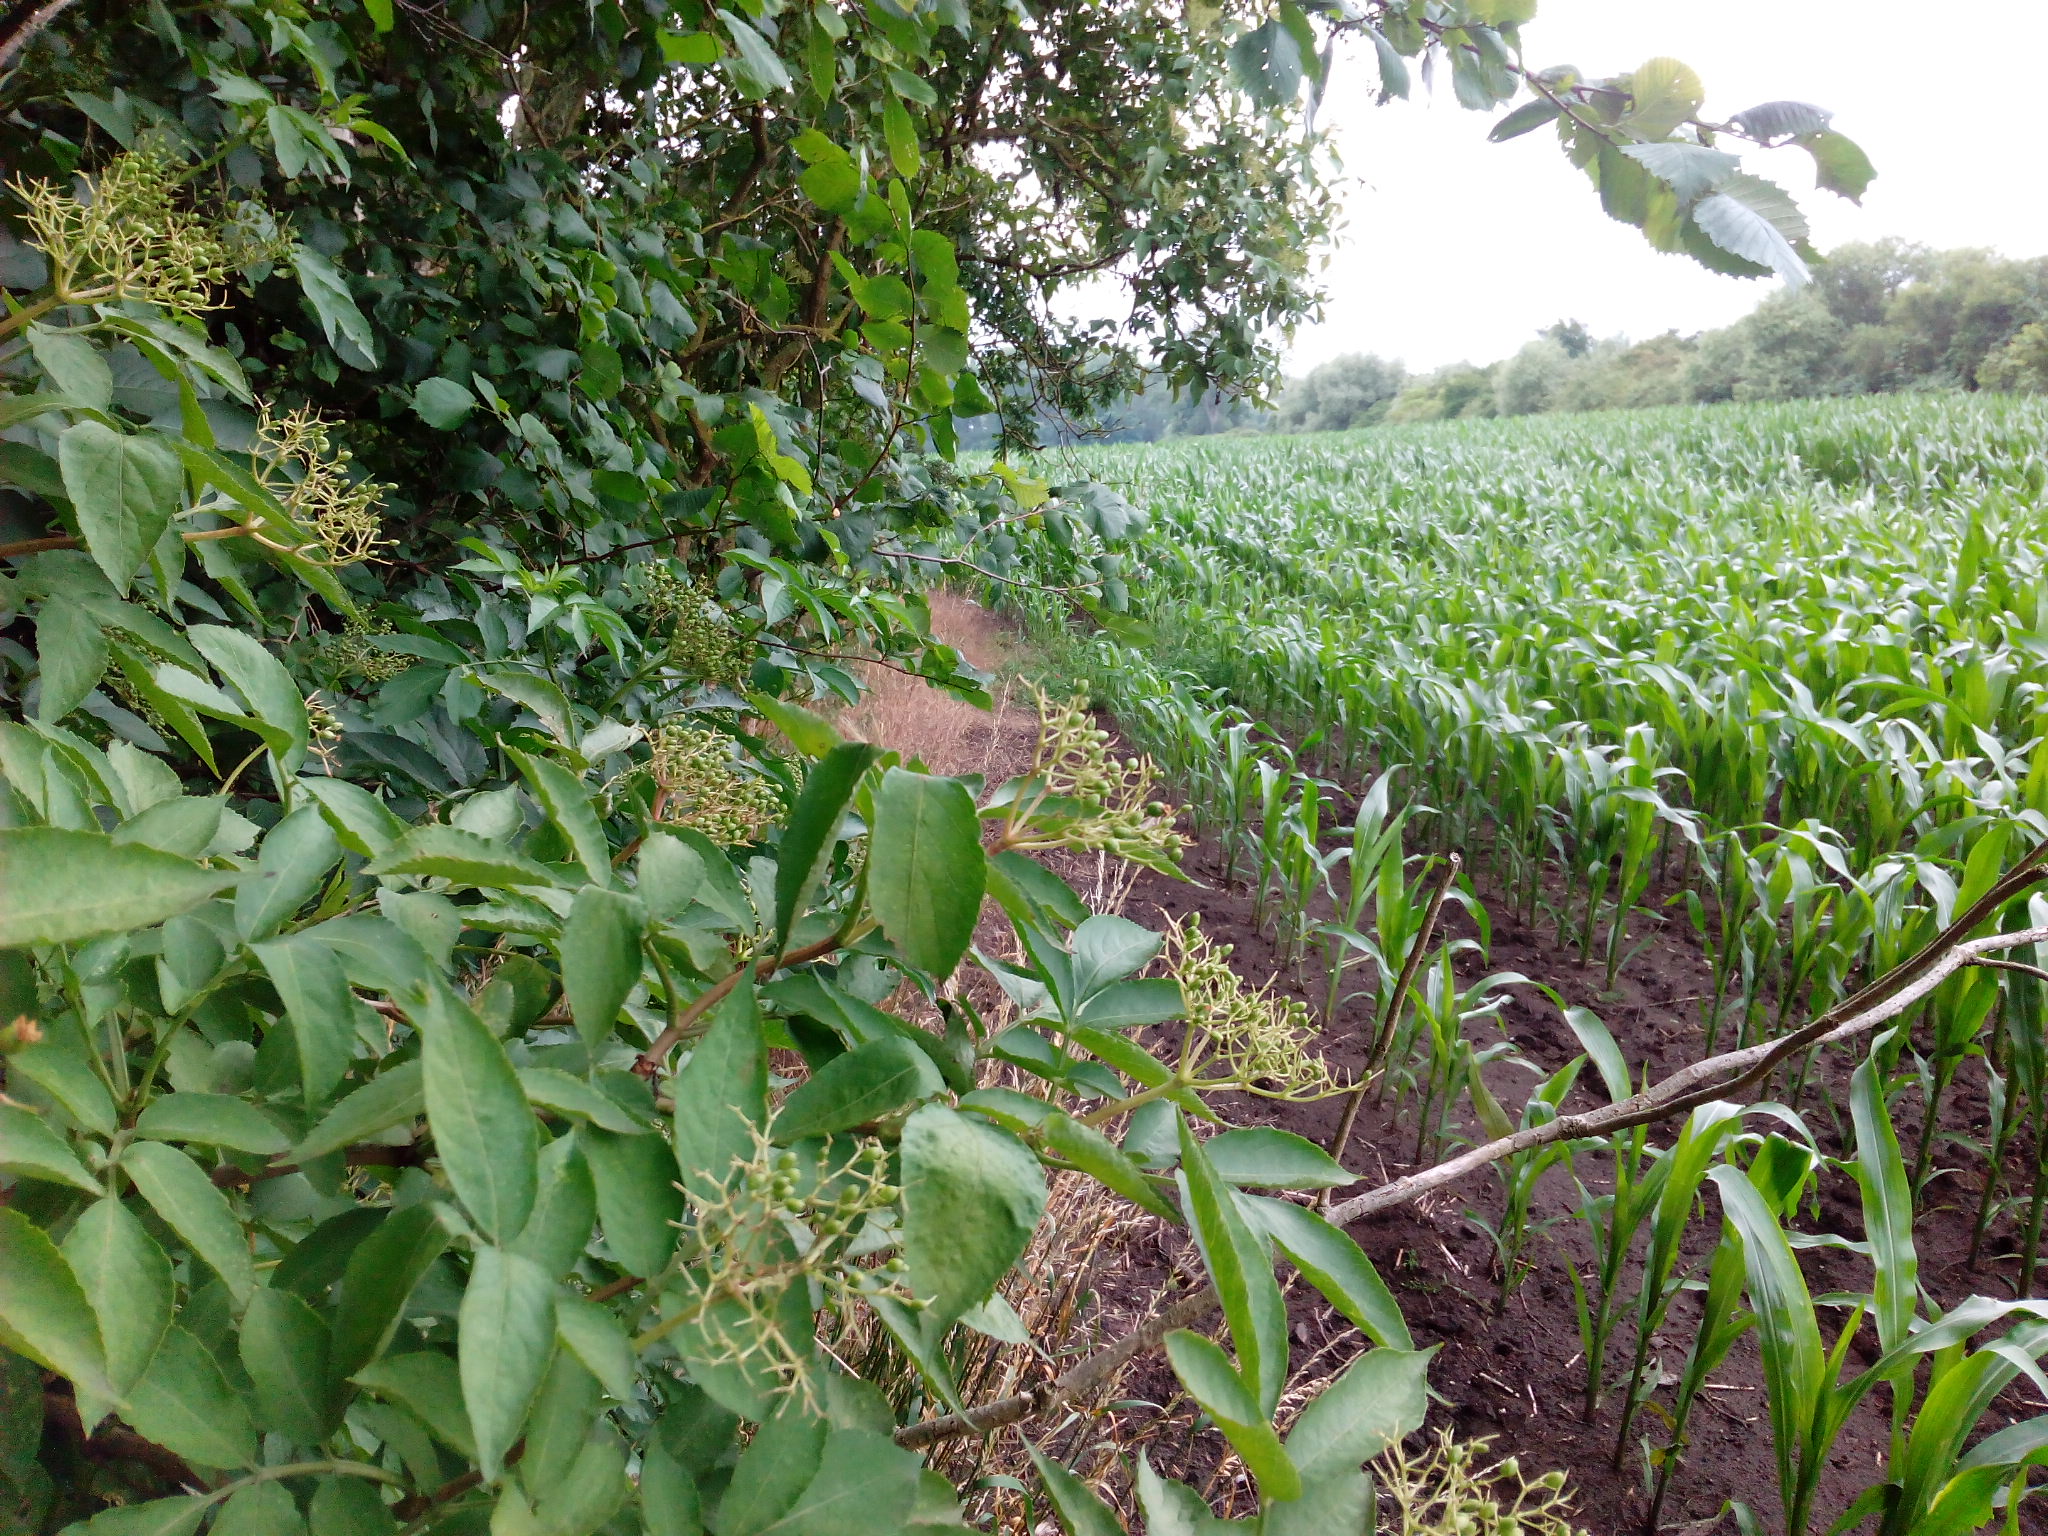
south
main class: Woodland
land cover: Broadleaved woodland
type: mesophytic deciduous forest
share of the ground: > 75 %
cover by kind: broadleaved forest trees 90 %, herbaceous plants 5 %, consolidated bare surface 5 %
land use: Semi-natural and natural areas not in use
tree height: > 5 m
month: July
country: DE
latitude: 53.3474
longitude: 14.1917
